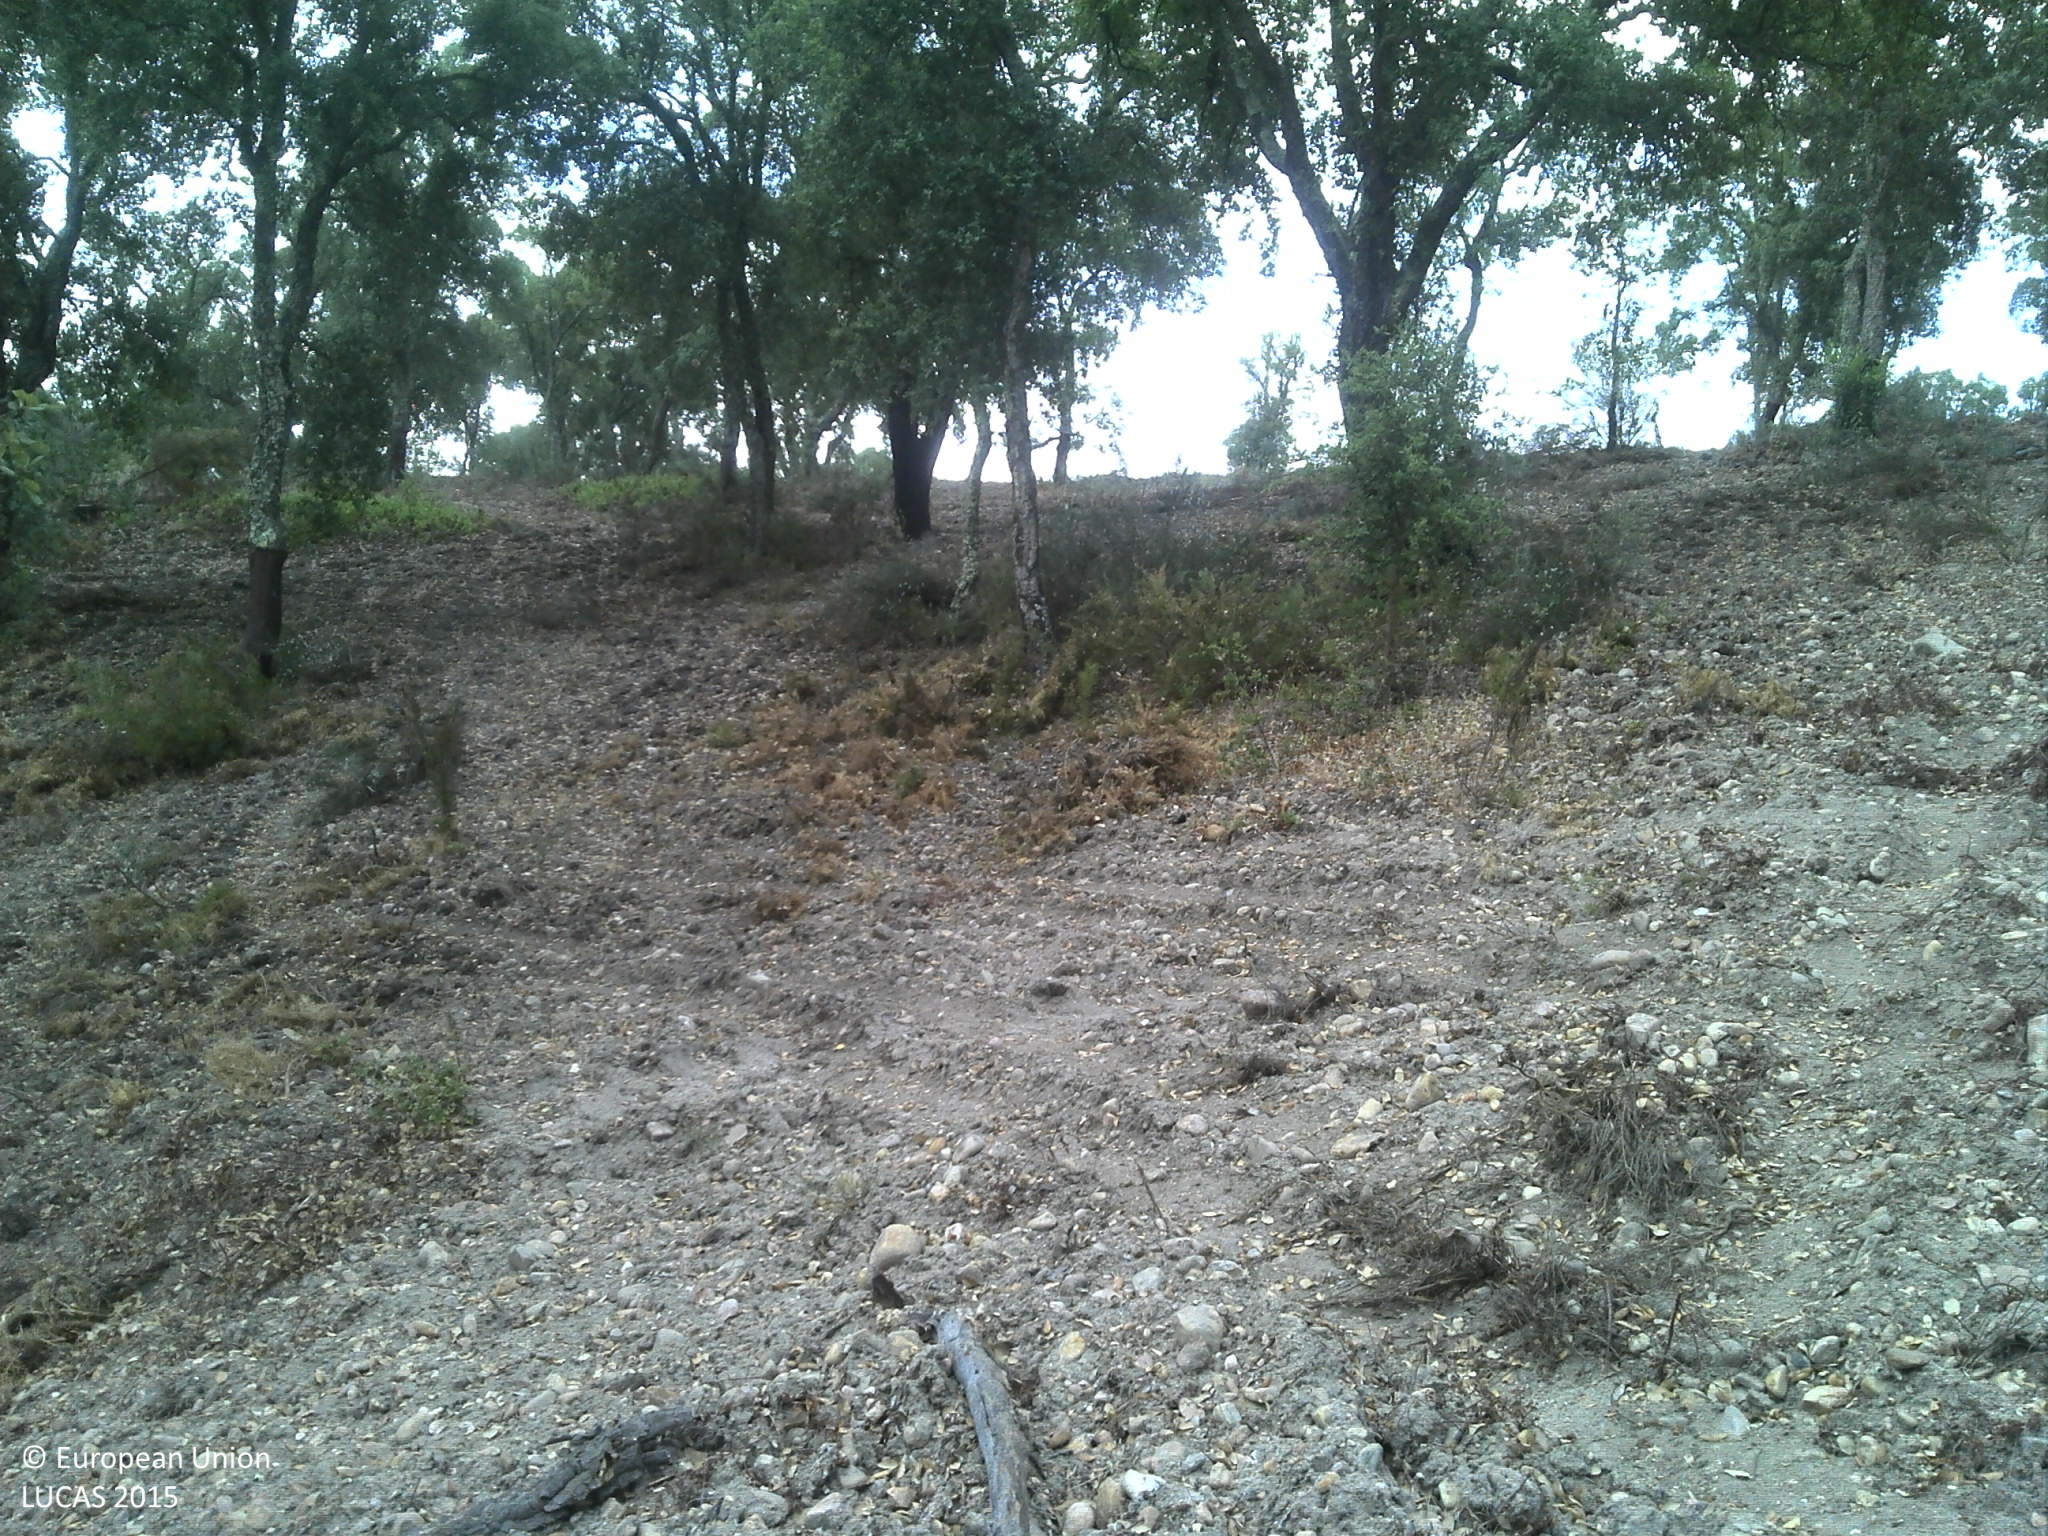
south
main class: Woodland
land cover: Broadleaved woodland
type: broadleaved evergreen forest
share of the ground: 25 - 50 %
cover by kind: broadleaved forest trees 50 %, unconsolidated bare surface 40 %, herbaceous plants 10 %
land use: Forestry
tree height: > 5 m
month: June
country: PT
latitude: 39.3351
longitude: -8.0516
